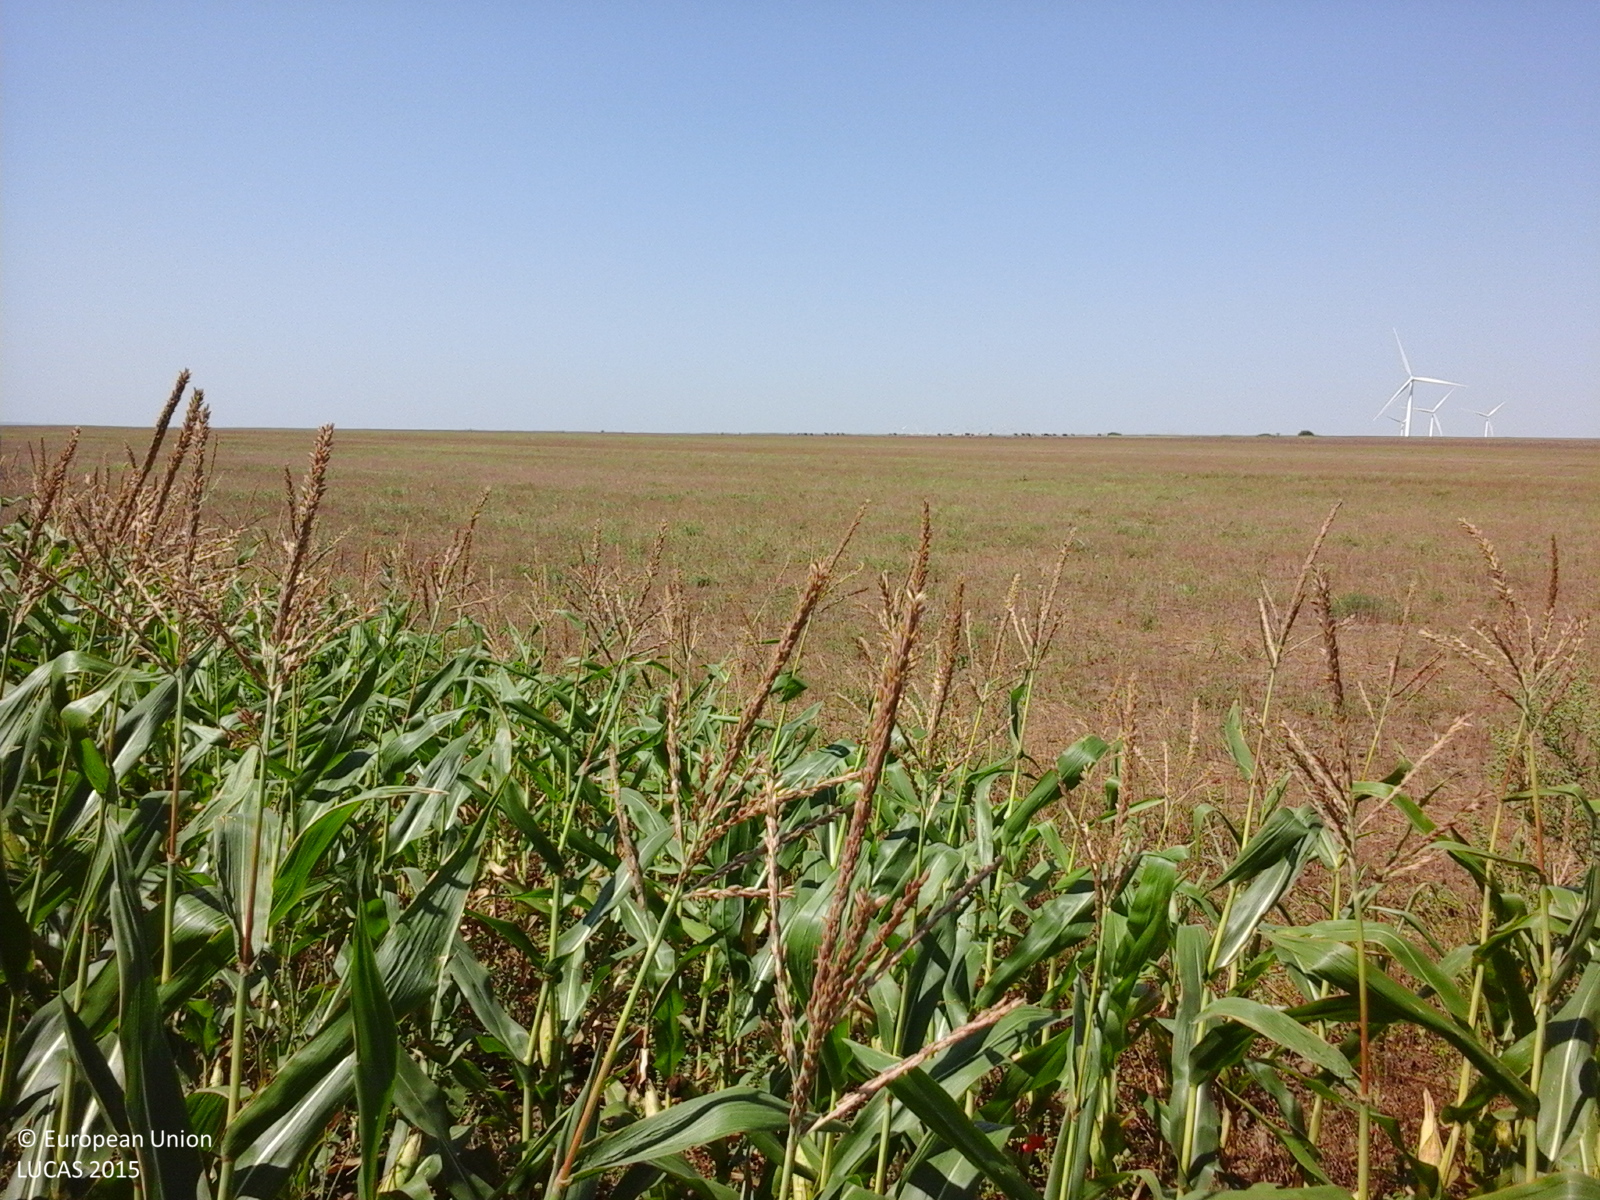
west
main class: Cropland
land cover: Maize
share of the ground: > 75 %
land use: Agriculture (excluding fallow land and kitchen gardens)
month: August
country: RO
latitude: 44.3499
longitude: 28.3962
